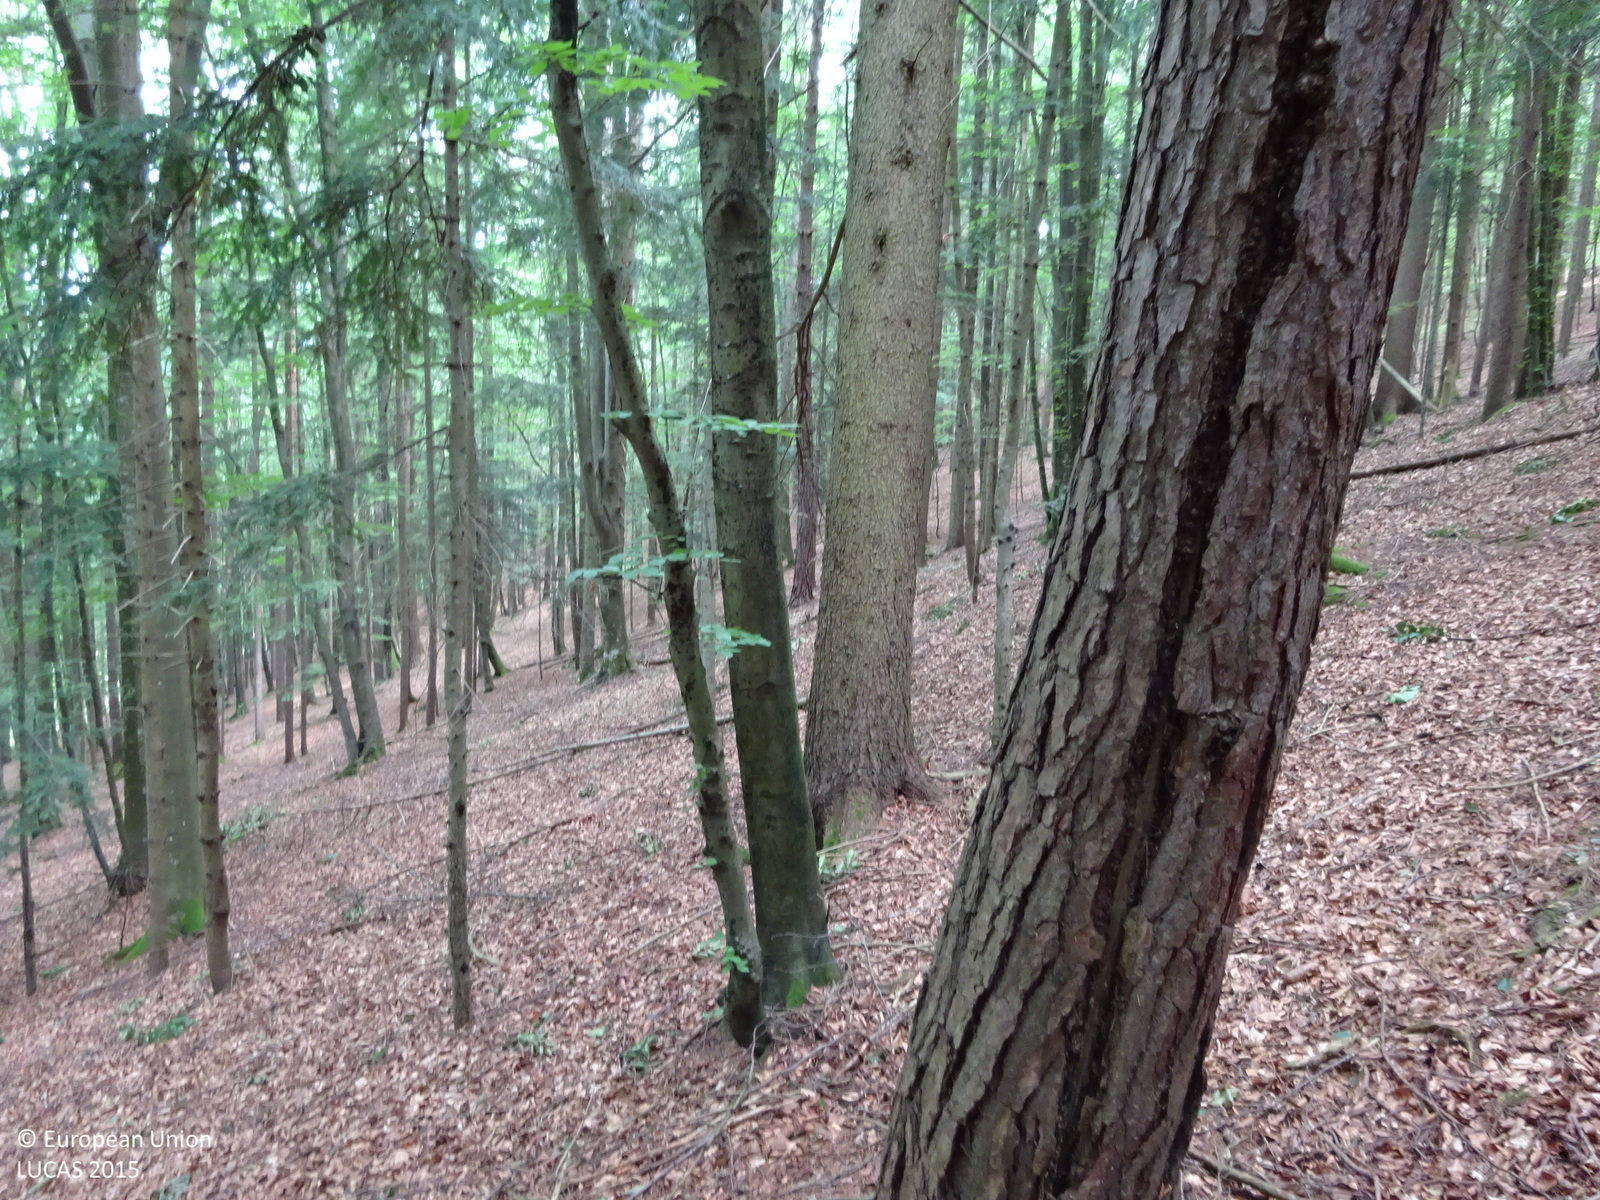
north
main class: Woodland
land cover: Spruce dominated mixed woodland
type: mountainous beech forest
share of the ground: > 75 %
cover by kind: coniferous forest trees 60 %, broadleaved forest trees 40 %
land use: Forestry
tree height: > 5 m
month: July
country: AT
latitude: 47.2573
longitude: 15.4844
